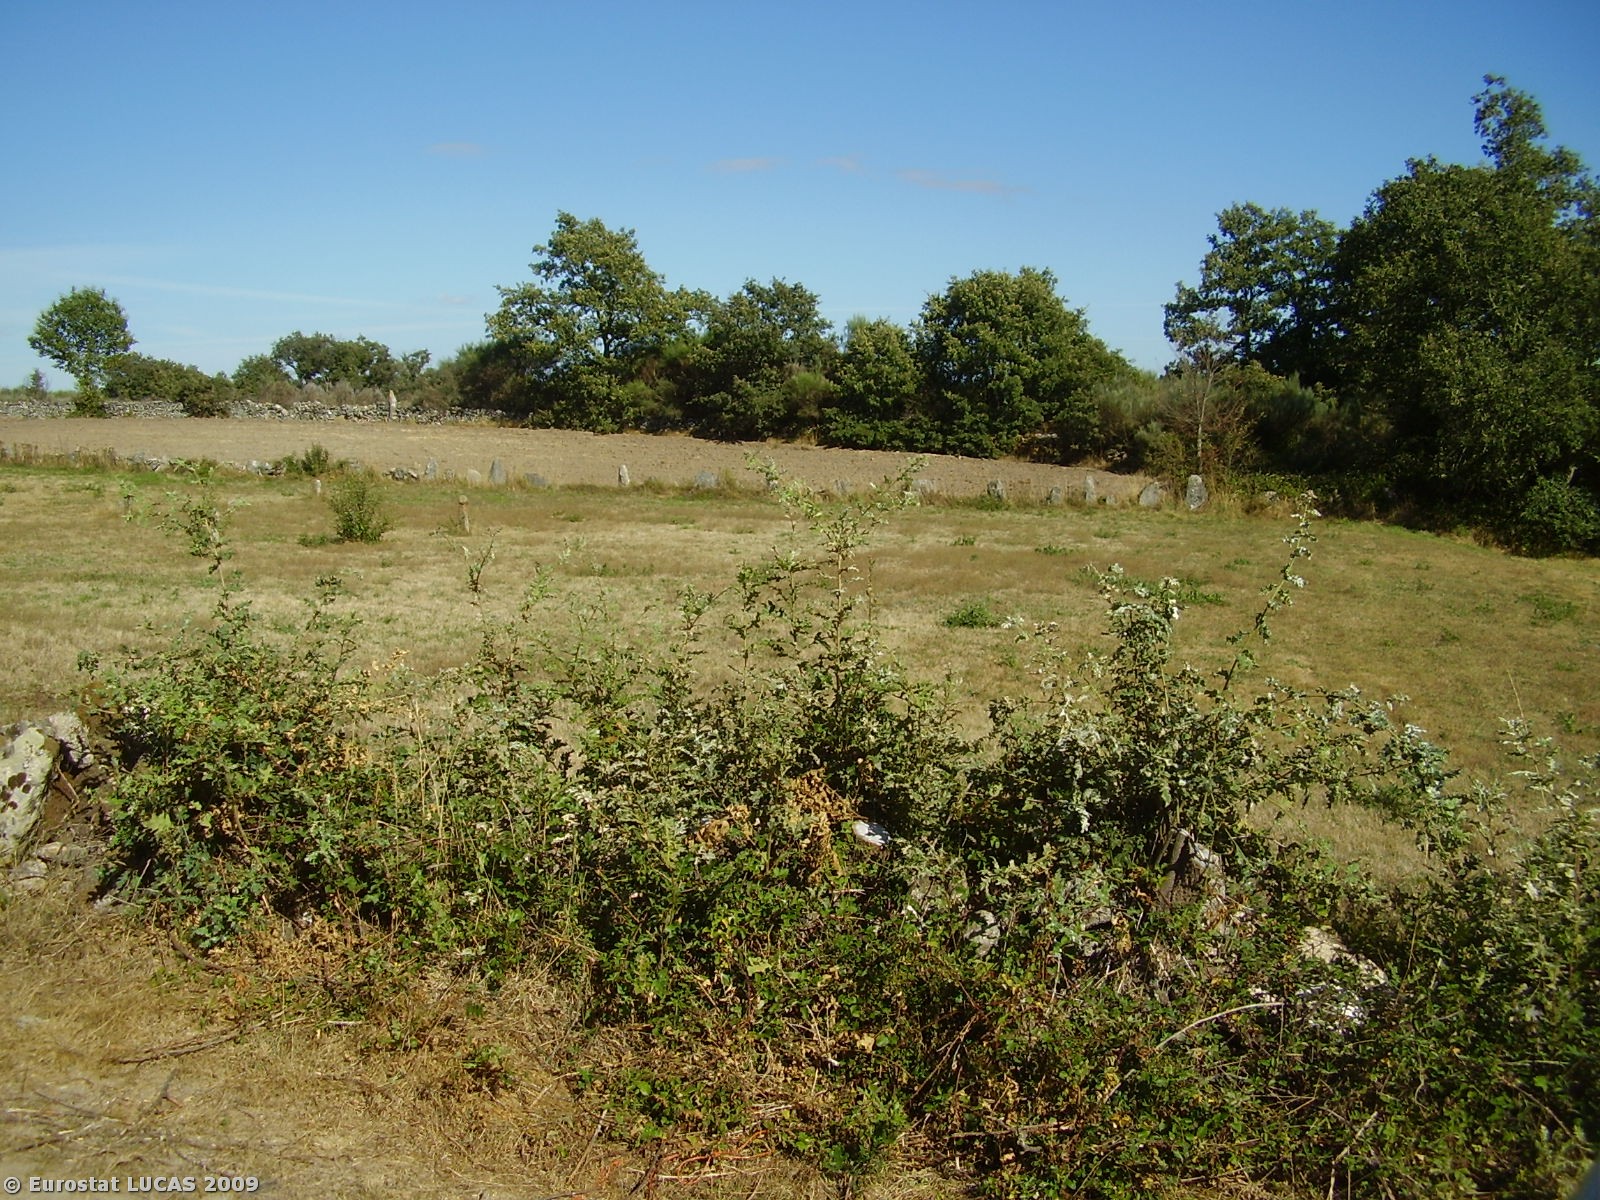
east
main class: Grassland
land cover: Grassland without tree/shrub cover
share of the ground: > 75 %
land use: Fallow land
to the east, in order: Grassland without tree/shrub cover; Dry stone walls; Tracks; Dry stone walls; Grassland without tree/shrub cover; Common wheat; Dry stone walls; Broadleaved woodland; Rye; Shrubland without tree cover; Rye; Dry stone walls; Shrubland without tree cover; Rye; Shrubland without tree cover
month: September
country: PT
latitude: 41.7696
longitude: -7.6627
